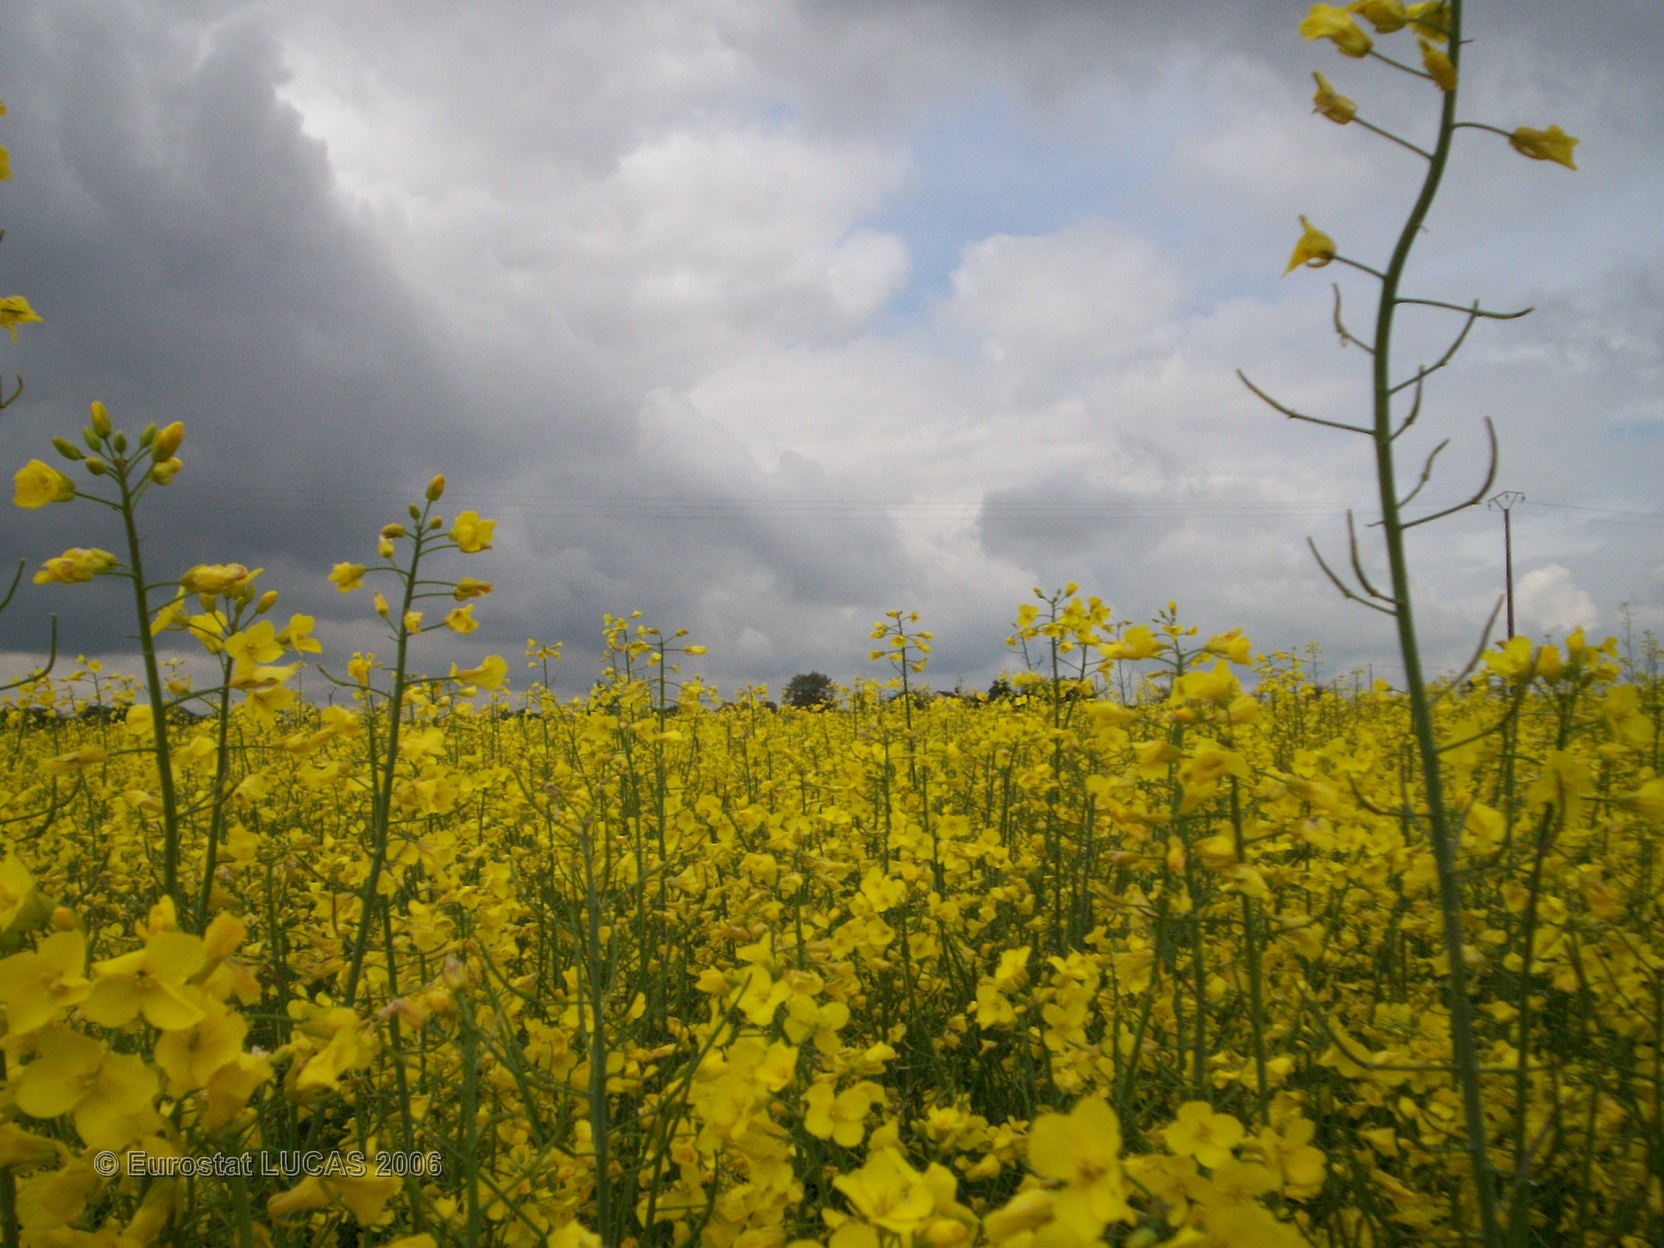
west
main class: Cropland
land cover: Rape and turnip rape
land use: Agriculture (excluding fallow land and kitchen gardens)
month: May
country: FR
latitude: 47.9445
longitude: 2.9641
